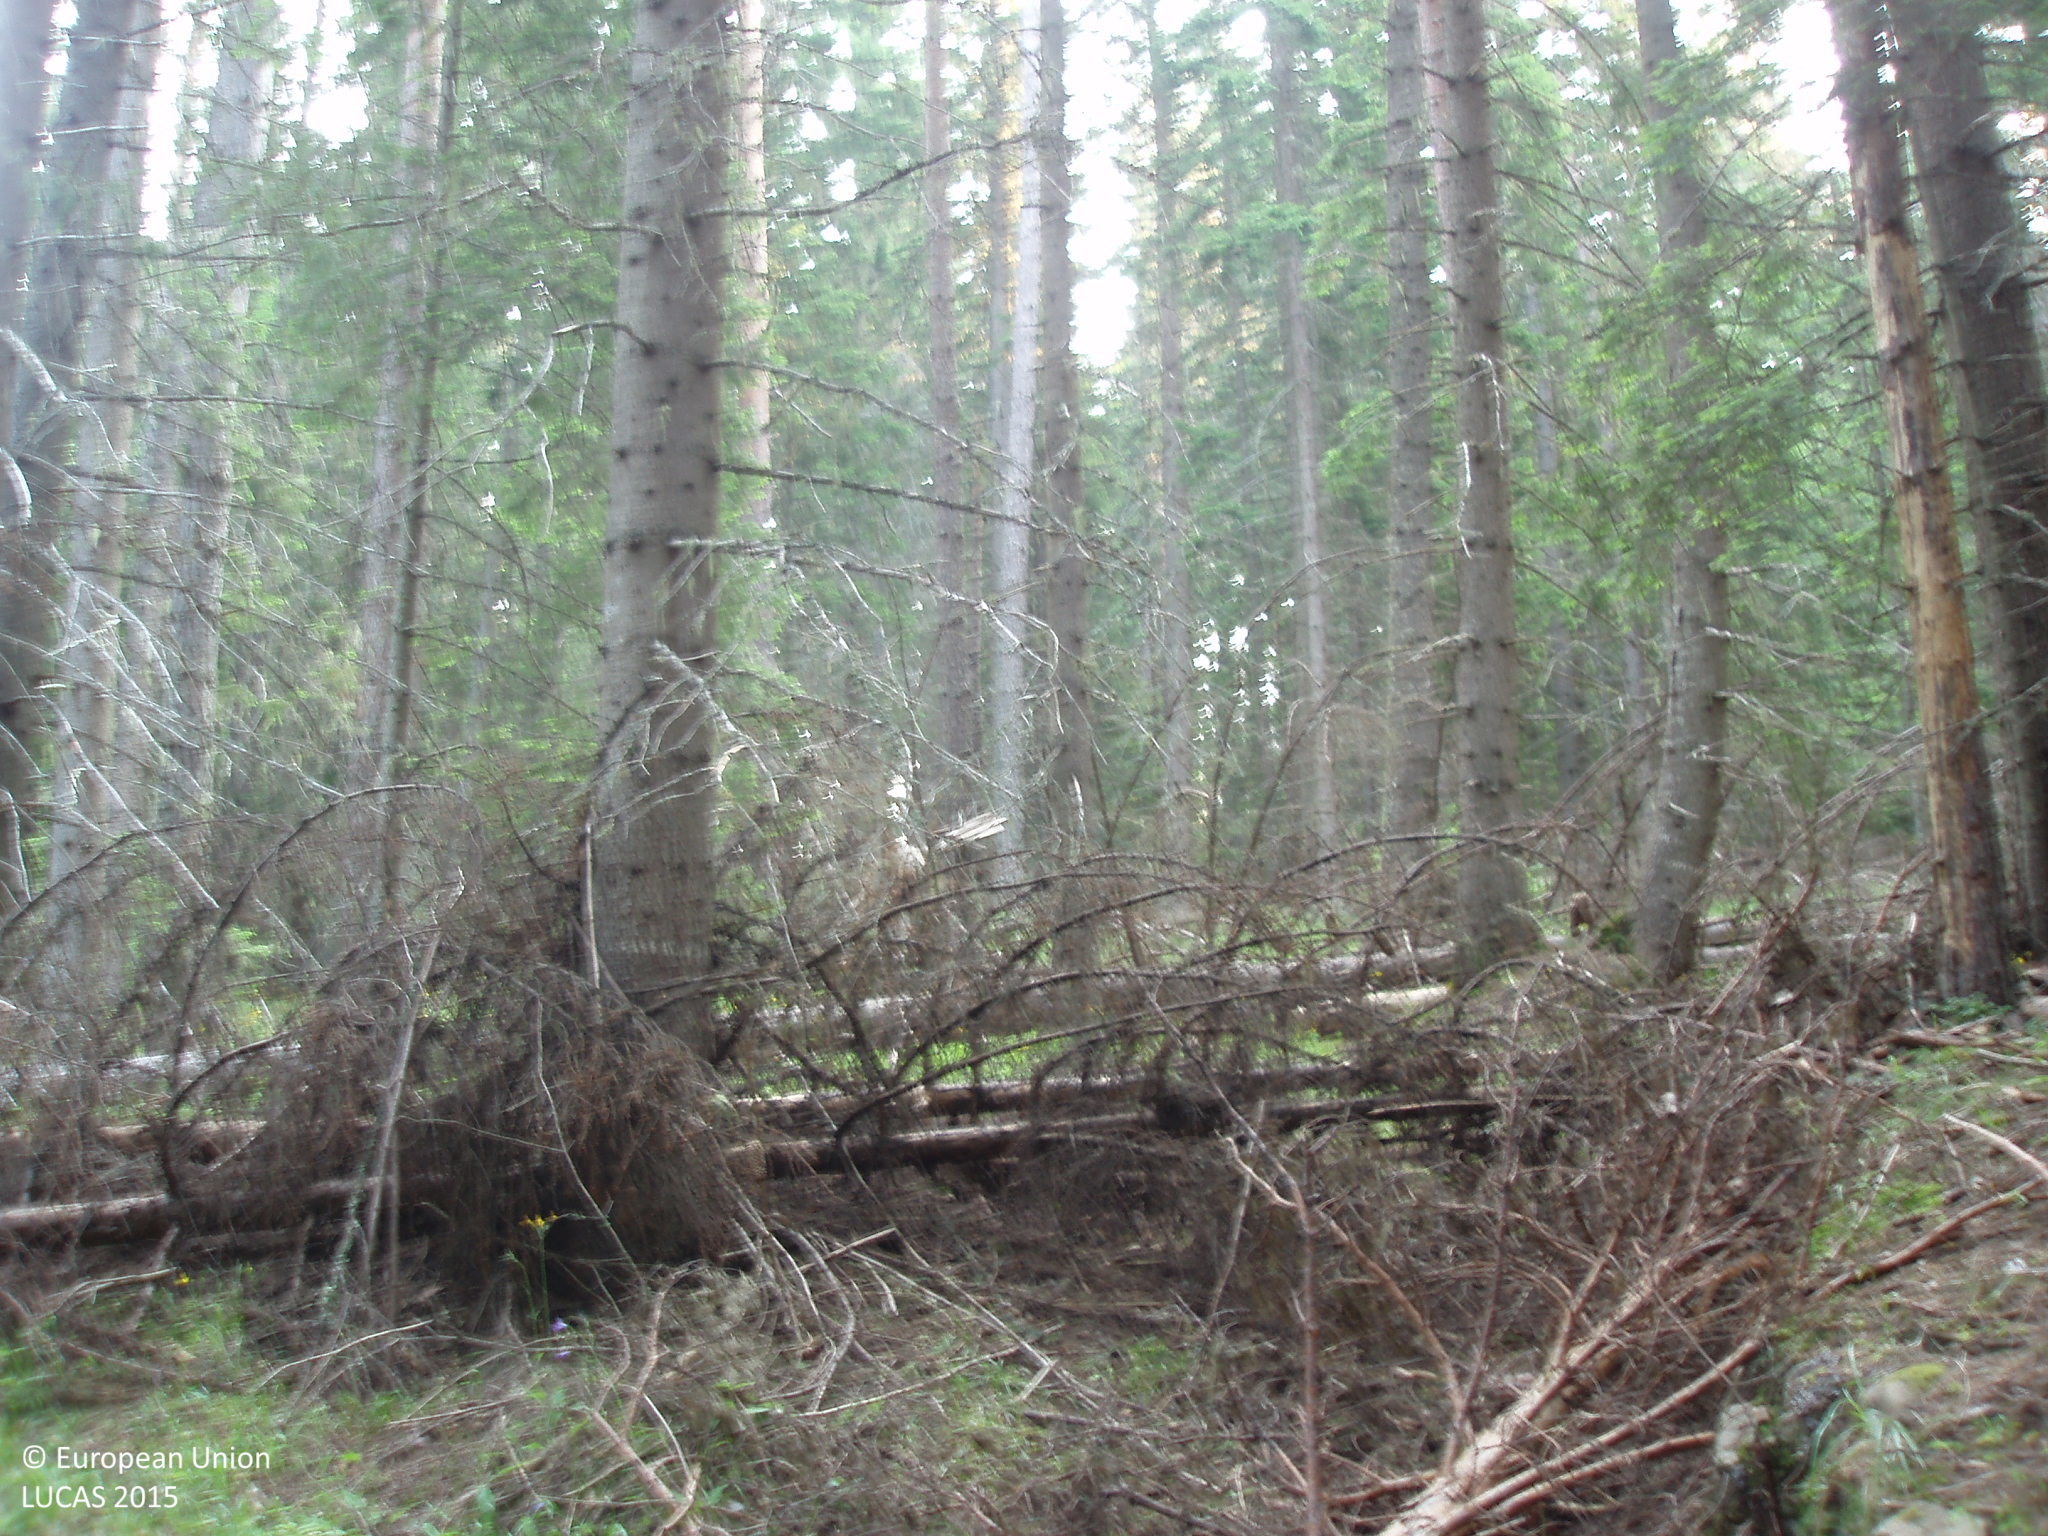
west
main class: Woodland
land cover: Spruce dominated coniferous woodland
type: hemiboreal forest and nemoral coniferous forest and mixed broadleaved-coniferous forest
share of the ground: > 75 %
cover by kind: coniferous forest trees 100 %
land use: Forestry
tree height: > 5 m
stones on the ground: 25 - 50 %
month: July
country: BG
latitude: 42.1010
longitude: 23.7098
